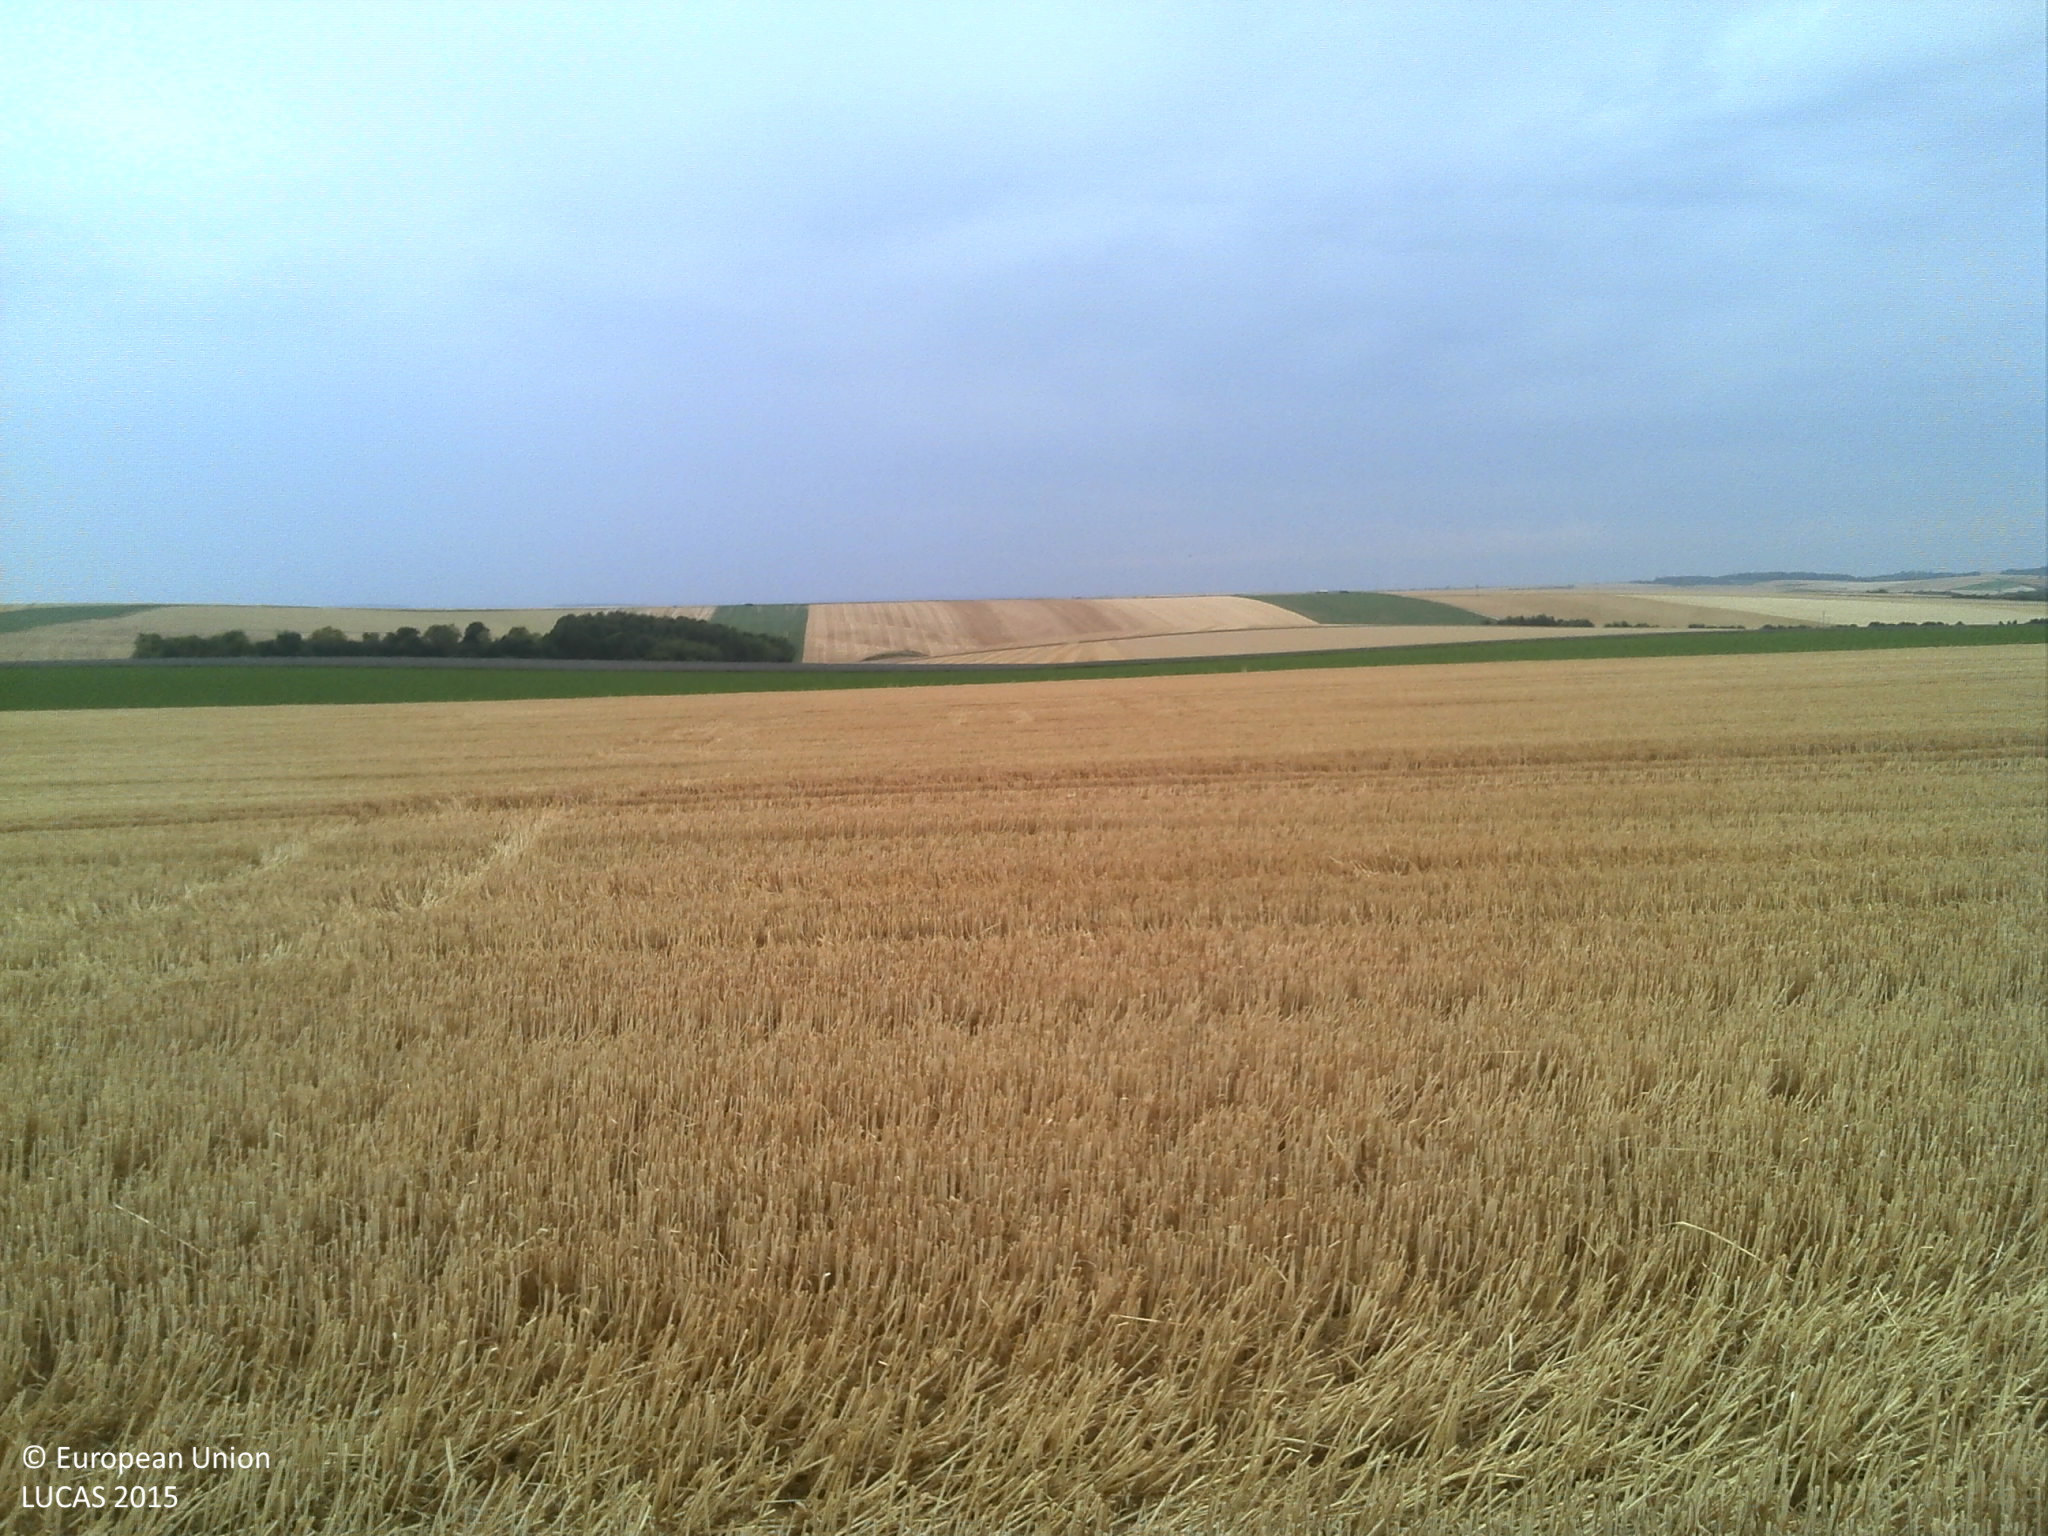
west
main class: Cropland
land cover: Common wheat
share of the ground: > 75 %
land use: Agriculture (excluding fallow land and kitchen gardens)
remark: Harvested field
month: July
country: FR
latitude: 49.4991
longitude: 4.2654
